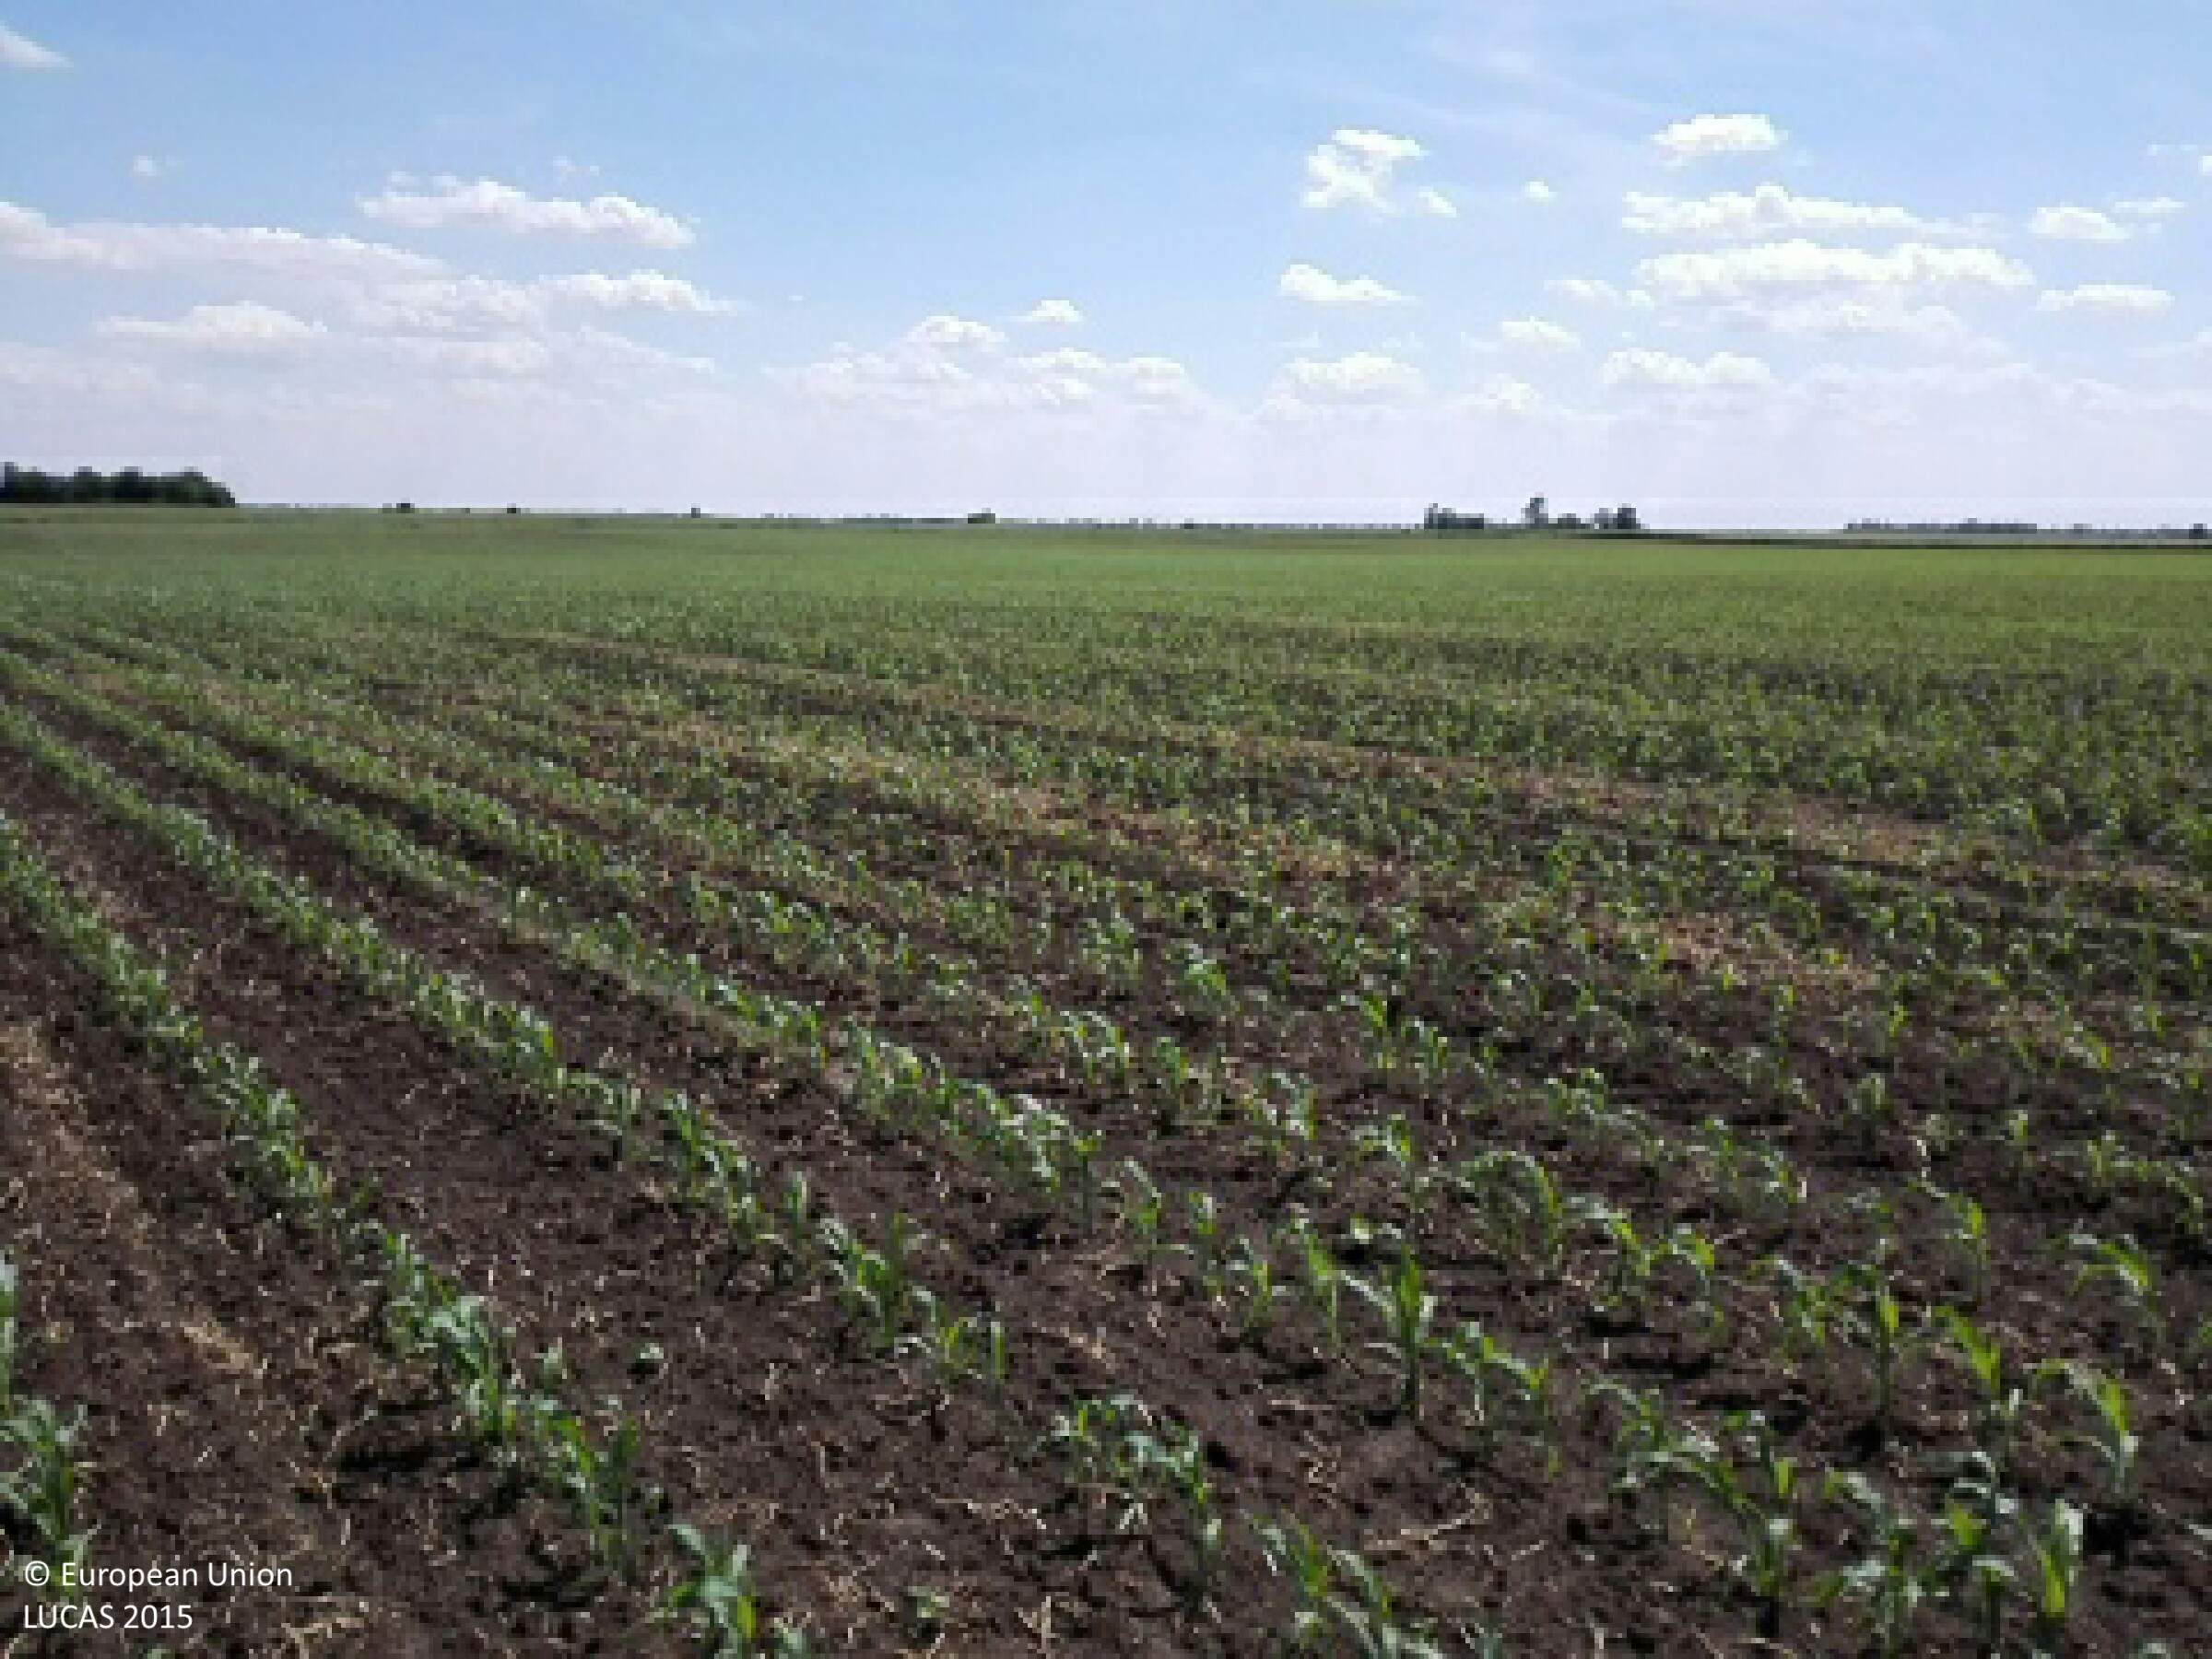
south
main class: Cropland
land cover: Maize
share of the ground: 10 - 25 %
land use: Agriculture (excluding fallow land and kitchen gardens)
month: July
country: HU
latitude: 47.3998
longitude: 21.3427
